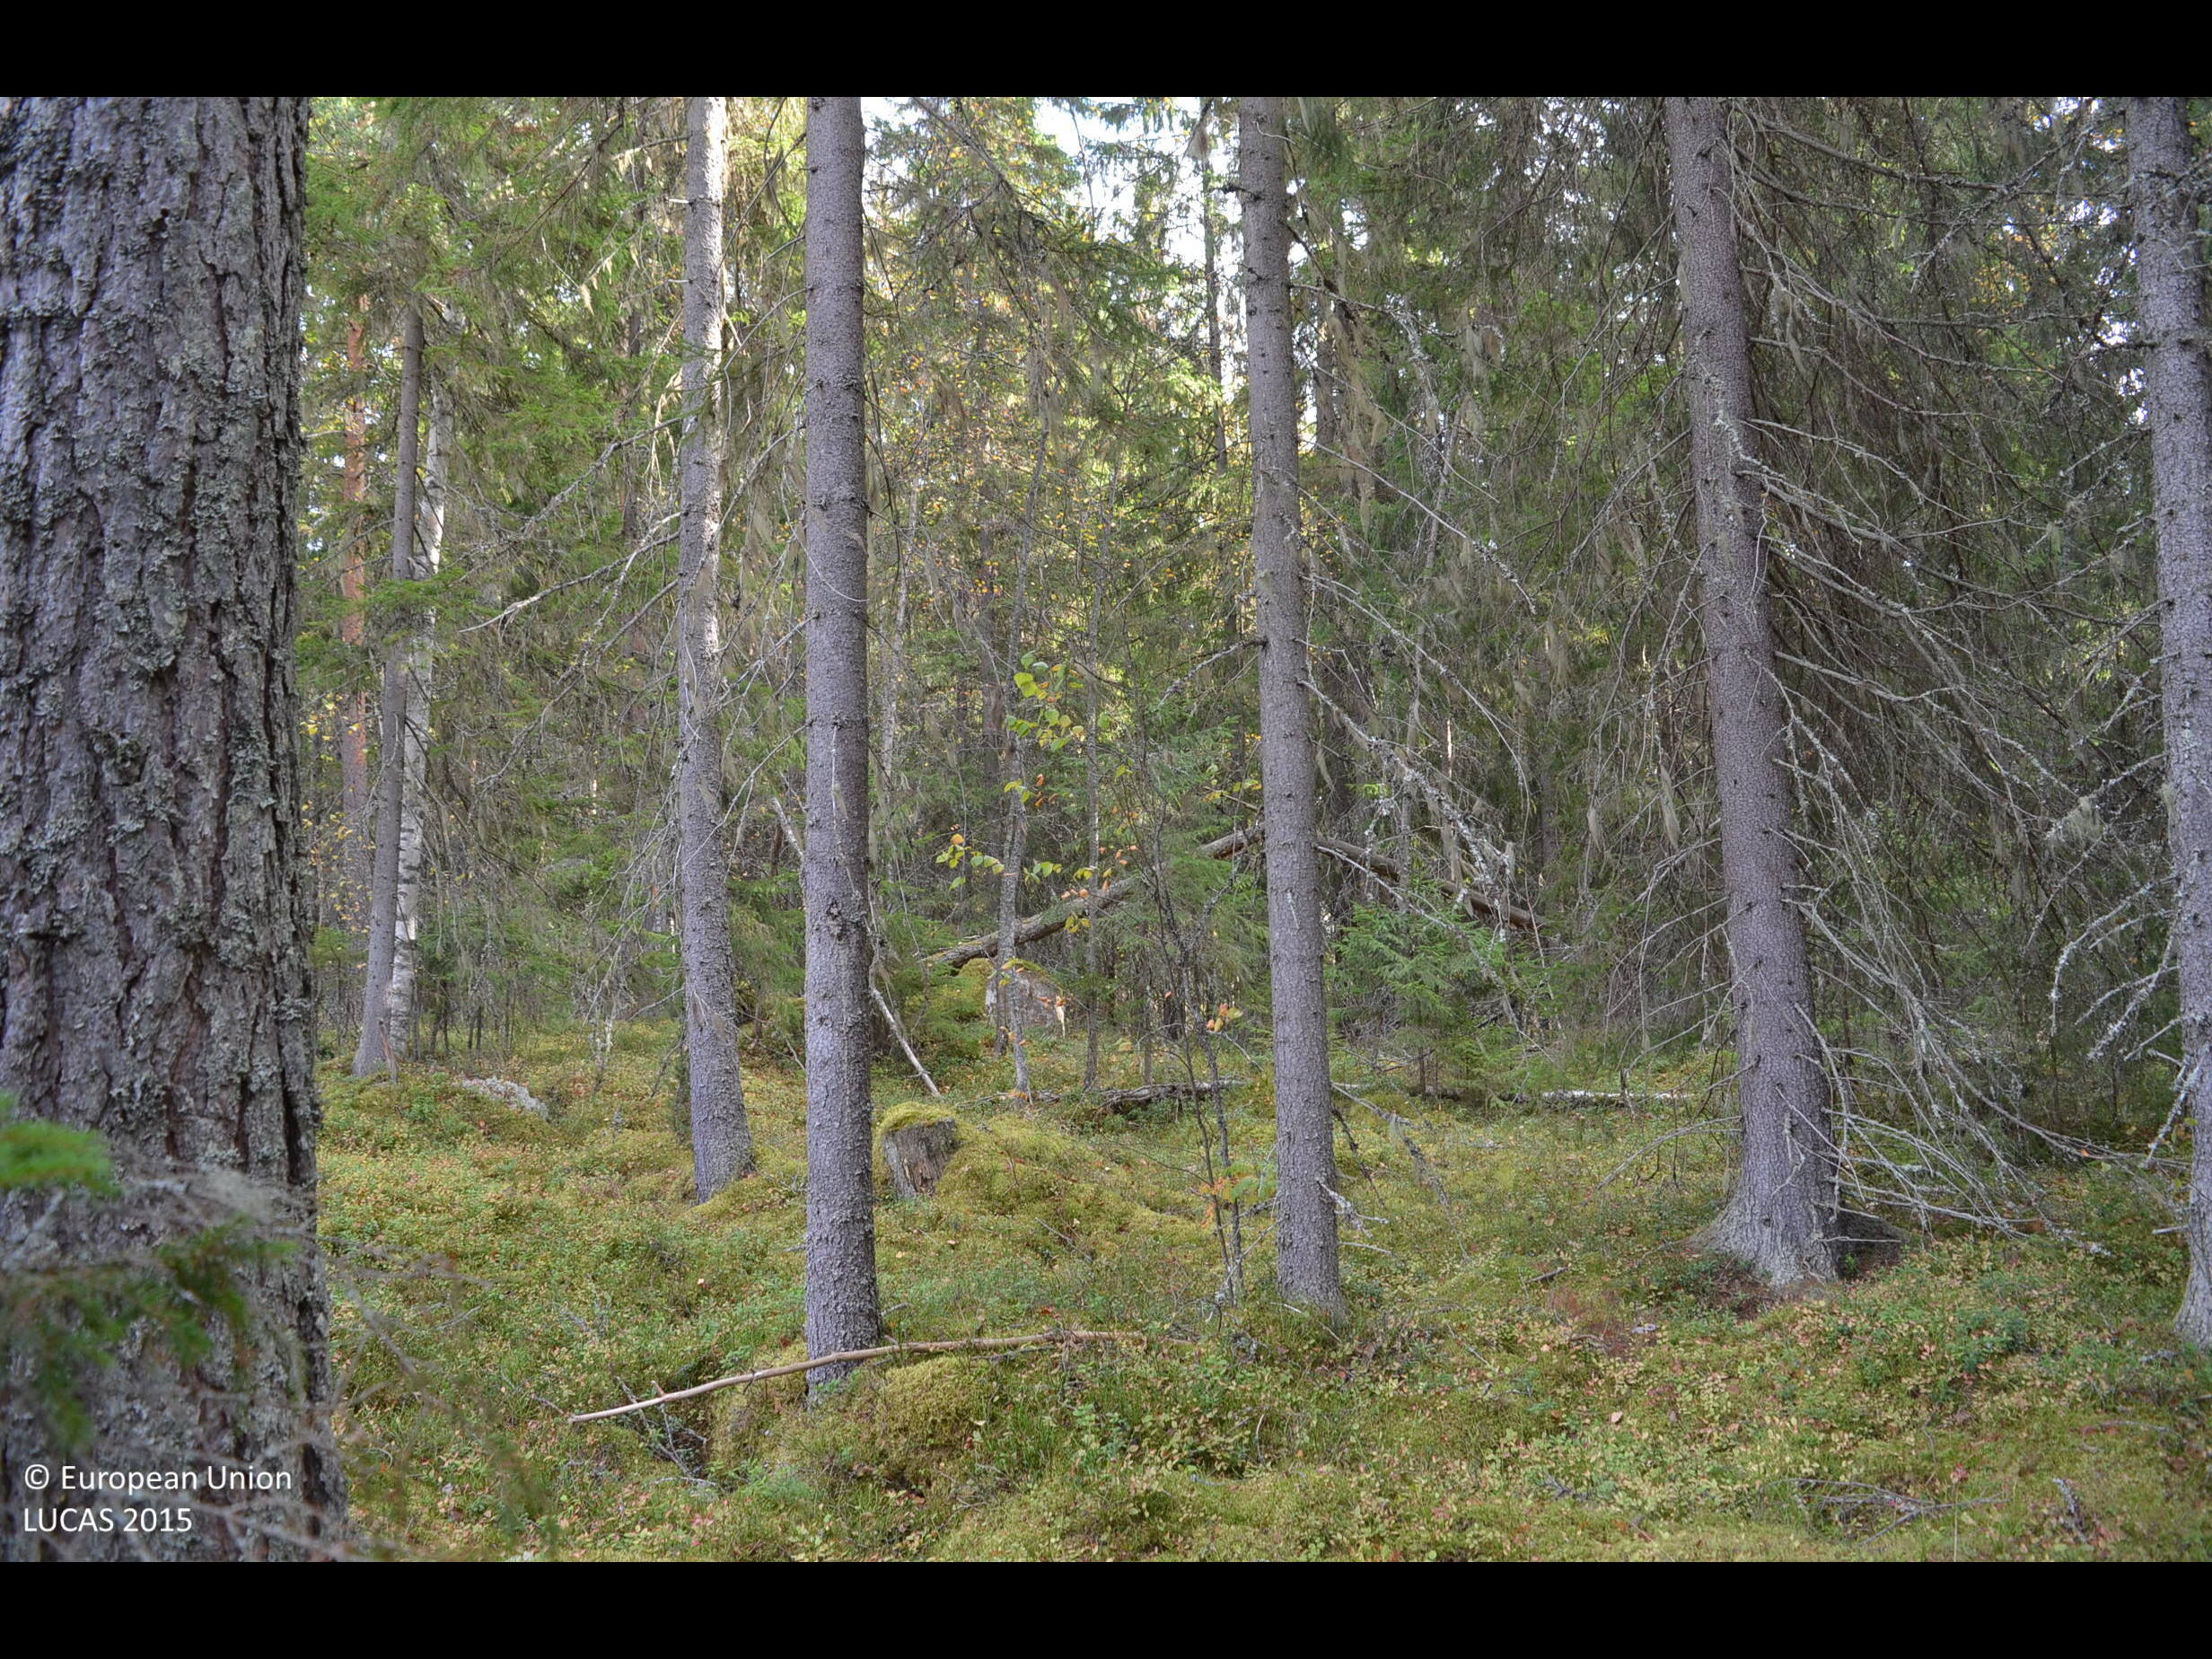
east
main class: Woodland
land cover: Other coniferous woodland
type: boreal forest
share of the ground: > 75 %
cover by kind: coniferous forest trees 70 %, lichens and mosses 15 %, shrubs 10 %, broadleaved forest trees 5 %
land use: Forestry
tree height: > 5 m
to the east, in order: Other coniferous woodland; Spruce dominated coniferous woodland; Spruce dominated mixed woodland
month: October
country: FI
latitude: 61.6703
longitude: 23.8938
